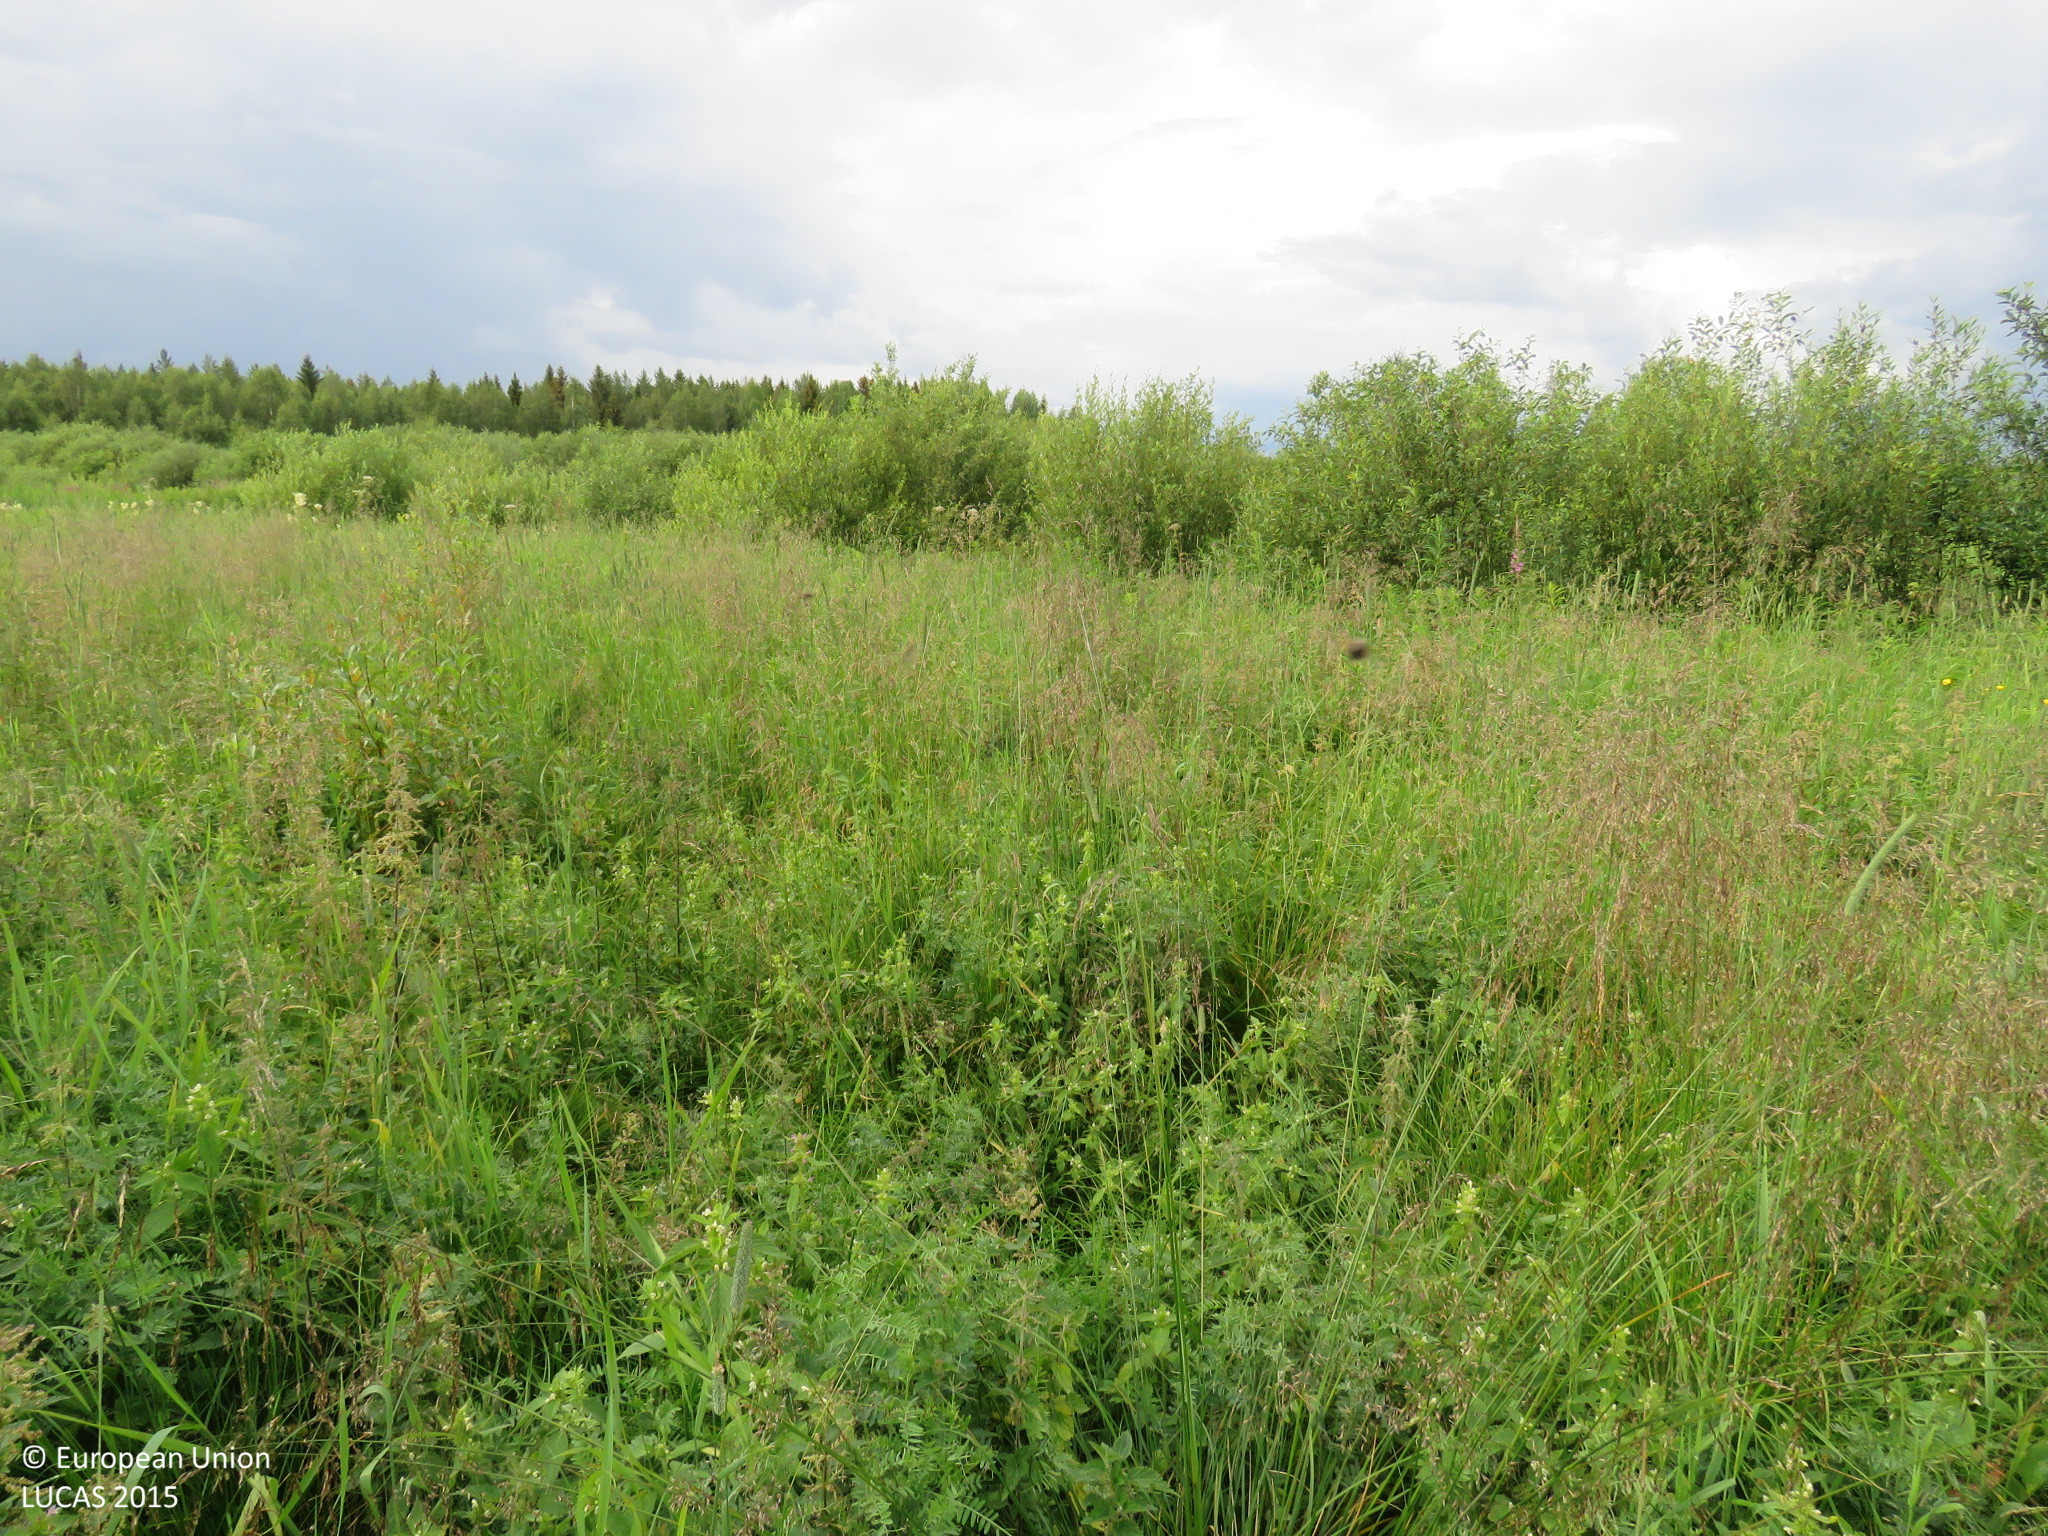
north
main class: Grassland
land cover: Spontaneously vegetated surfaces
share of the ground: > 75 %
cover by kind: herbaceous plants 95 %, shrubs 5 %
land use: Fallow land
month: July
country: FI
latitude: 64.6112
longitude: 26.2225
